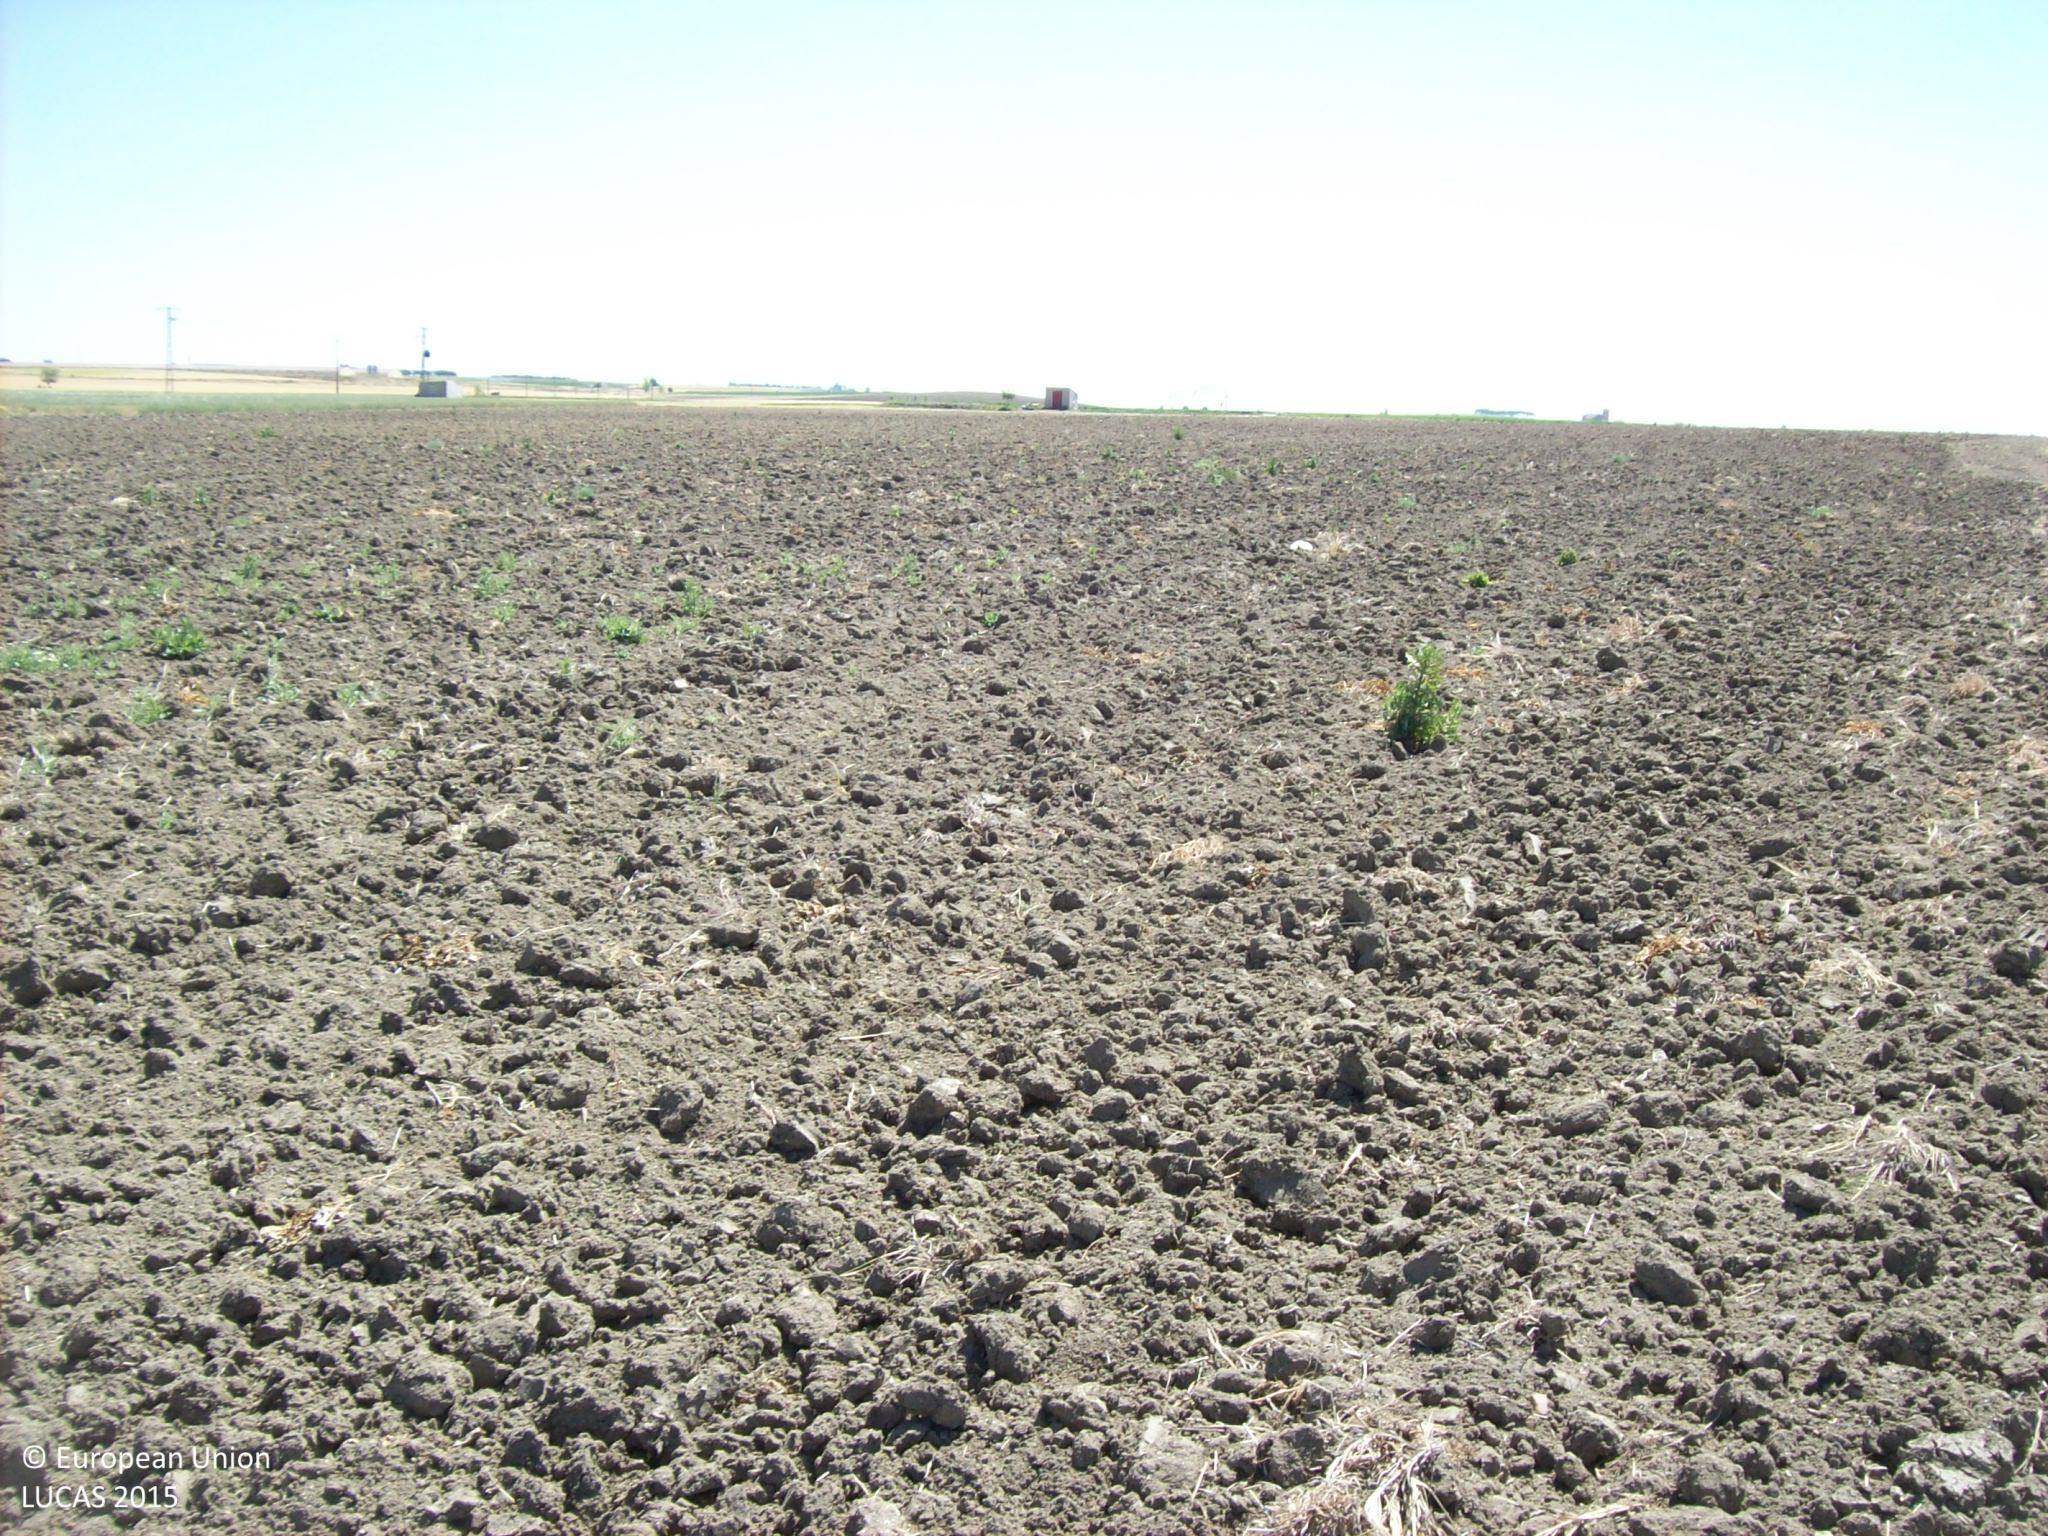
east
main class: Grassland
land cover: Spontaneously vegetated surfaces
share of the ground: 10 - 25 %
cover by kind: unconsolidated bare surface 60 %, herbaceous plants 15 %
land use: Fallow land
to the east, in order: Spontaneously vegetated surfaces; Other bare soil
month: May
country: ES
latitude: 40.8939
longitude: -4.9594
